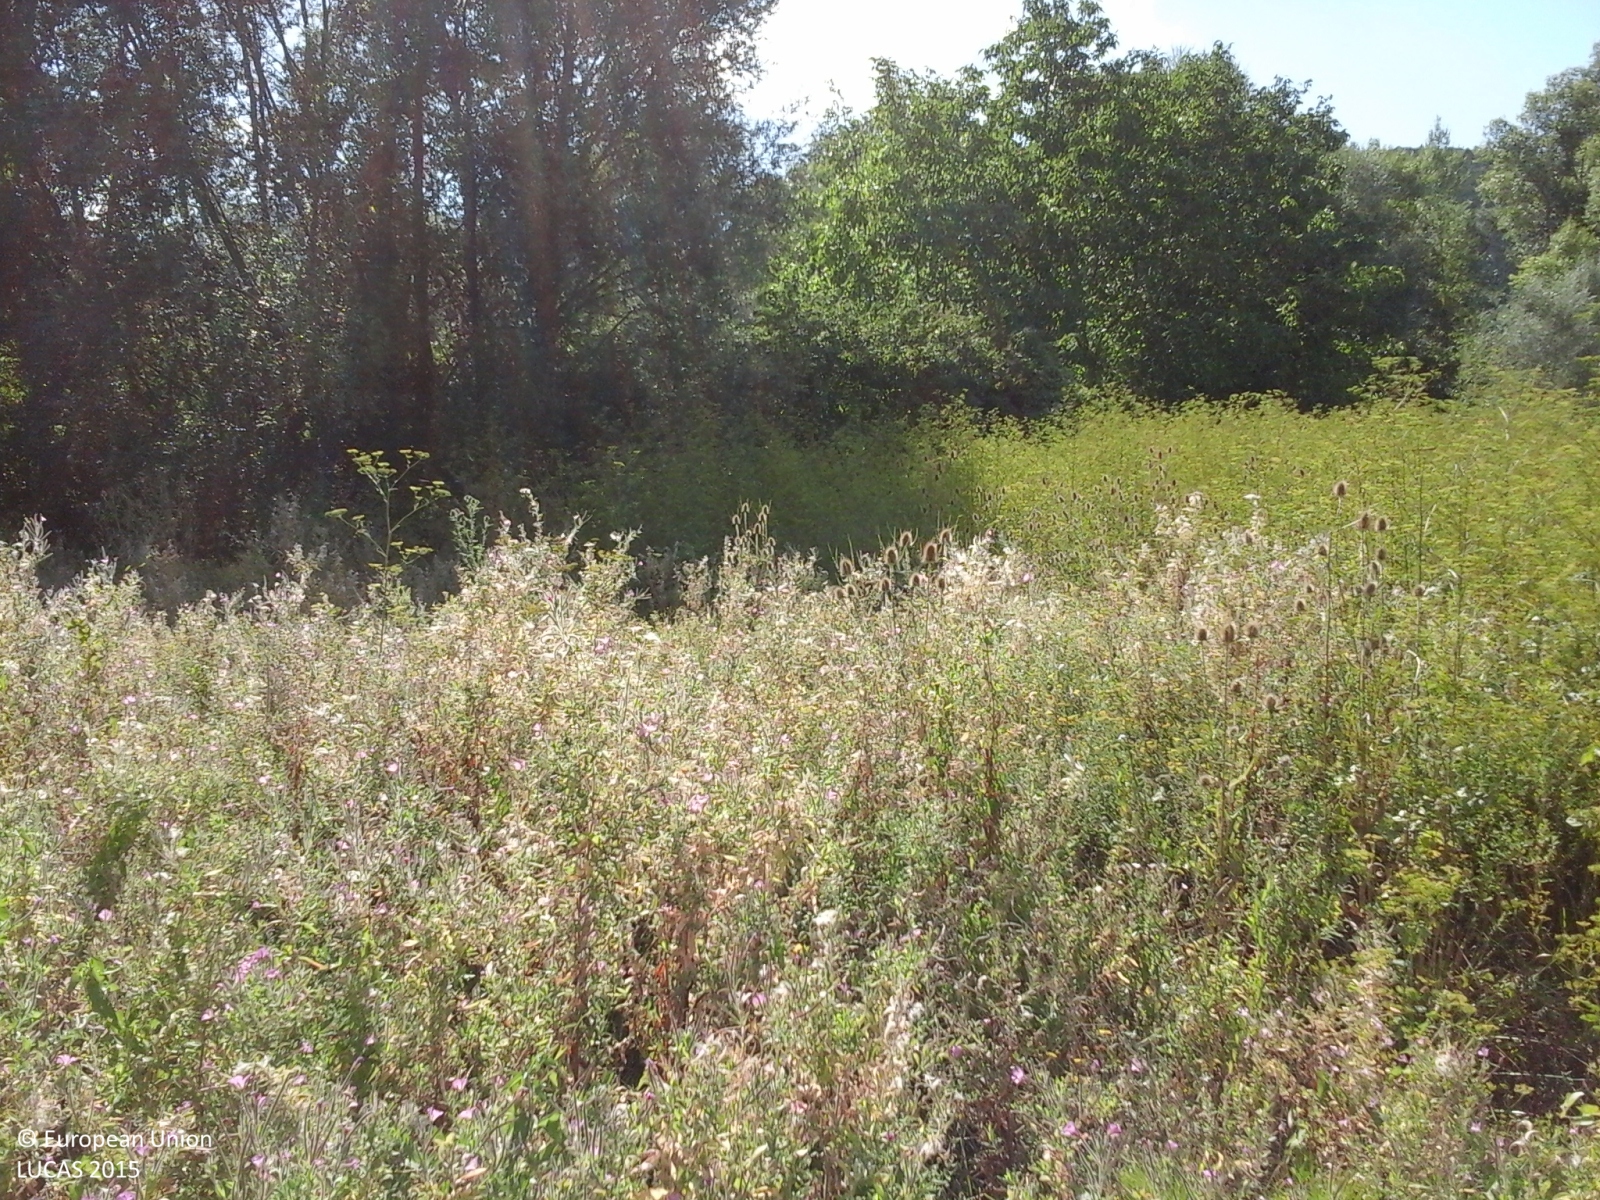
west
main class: Grassland
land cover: Spontaneously vegetated surfaces
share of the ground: > 75 %
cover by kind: herbaceous plants 100 %
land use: Fallow land
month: August
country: IT
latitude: 41.5470
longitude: 14.3600
